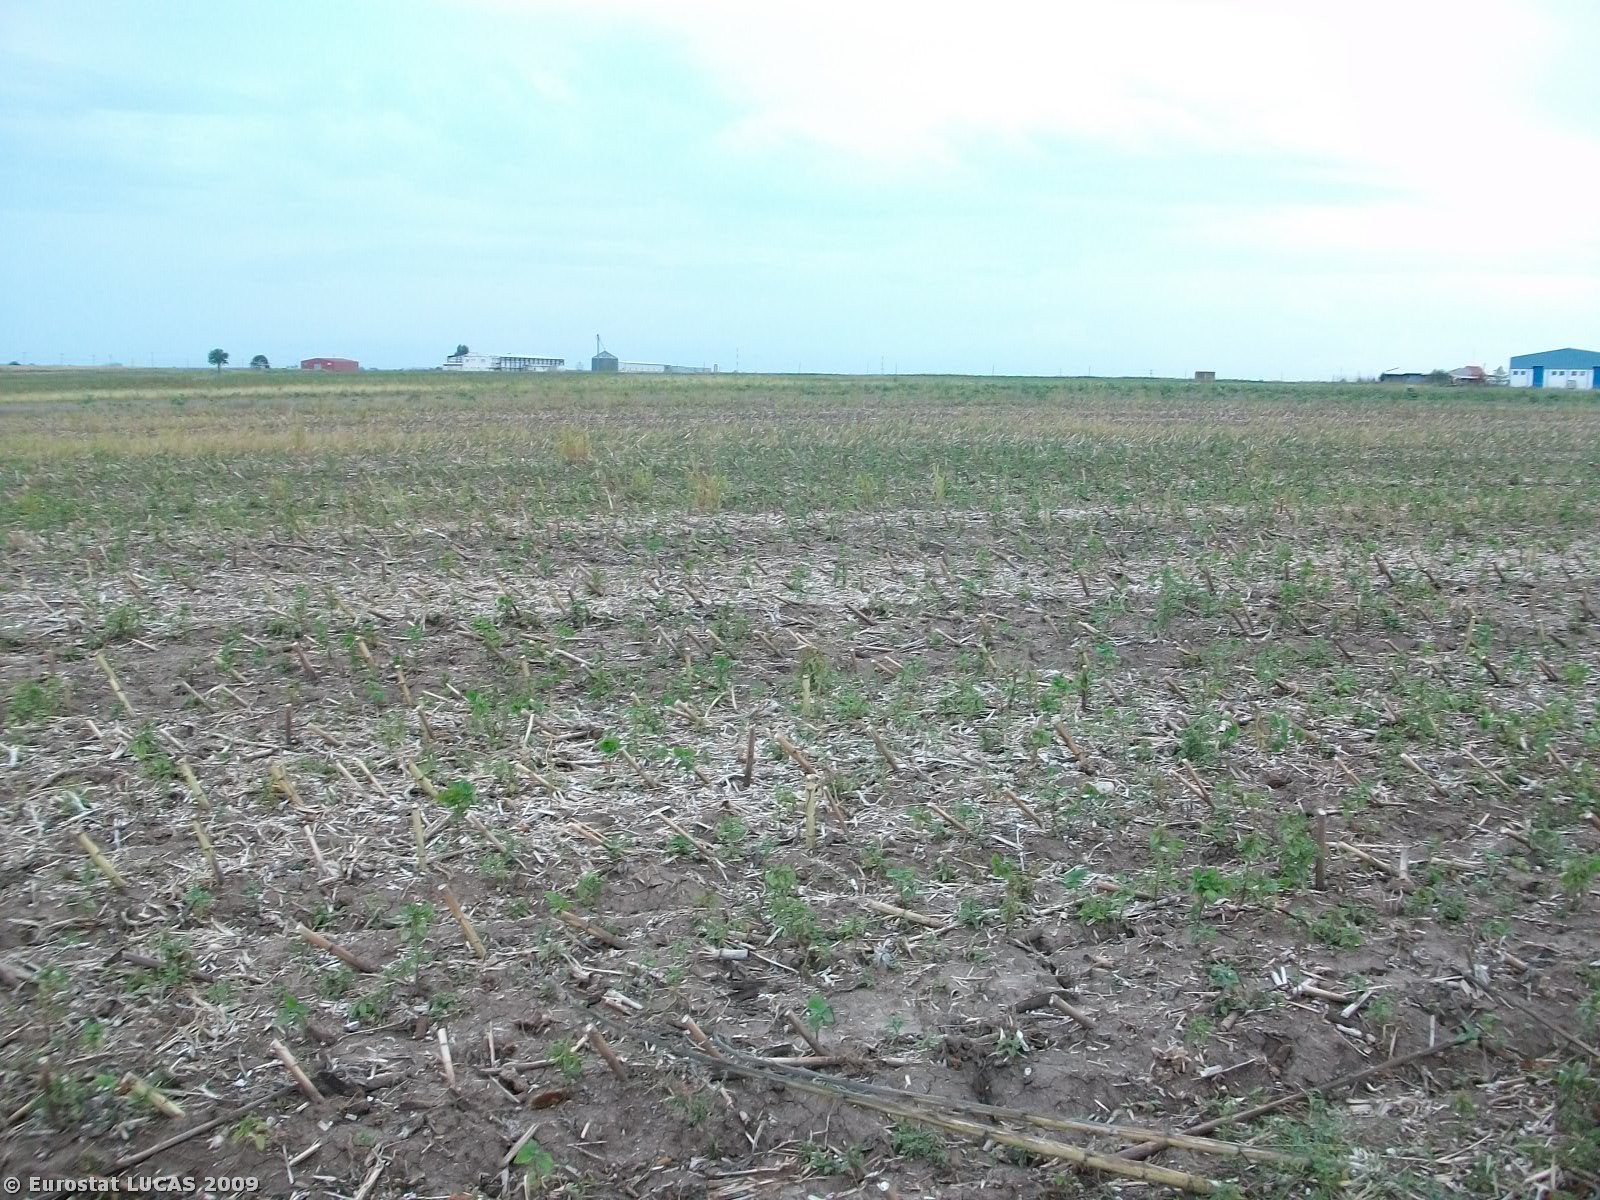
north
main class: Cropland
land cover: Sunflower
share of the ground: < 10 %
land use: Agriculture (excluding fallow land and kitchen gardens)
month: September
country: GR
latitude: 41.5449
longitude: 26.5149
